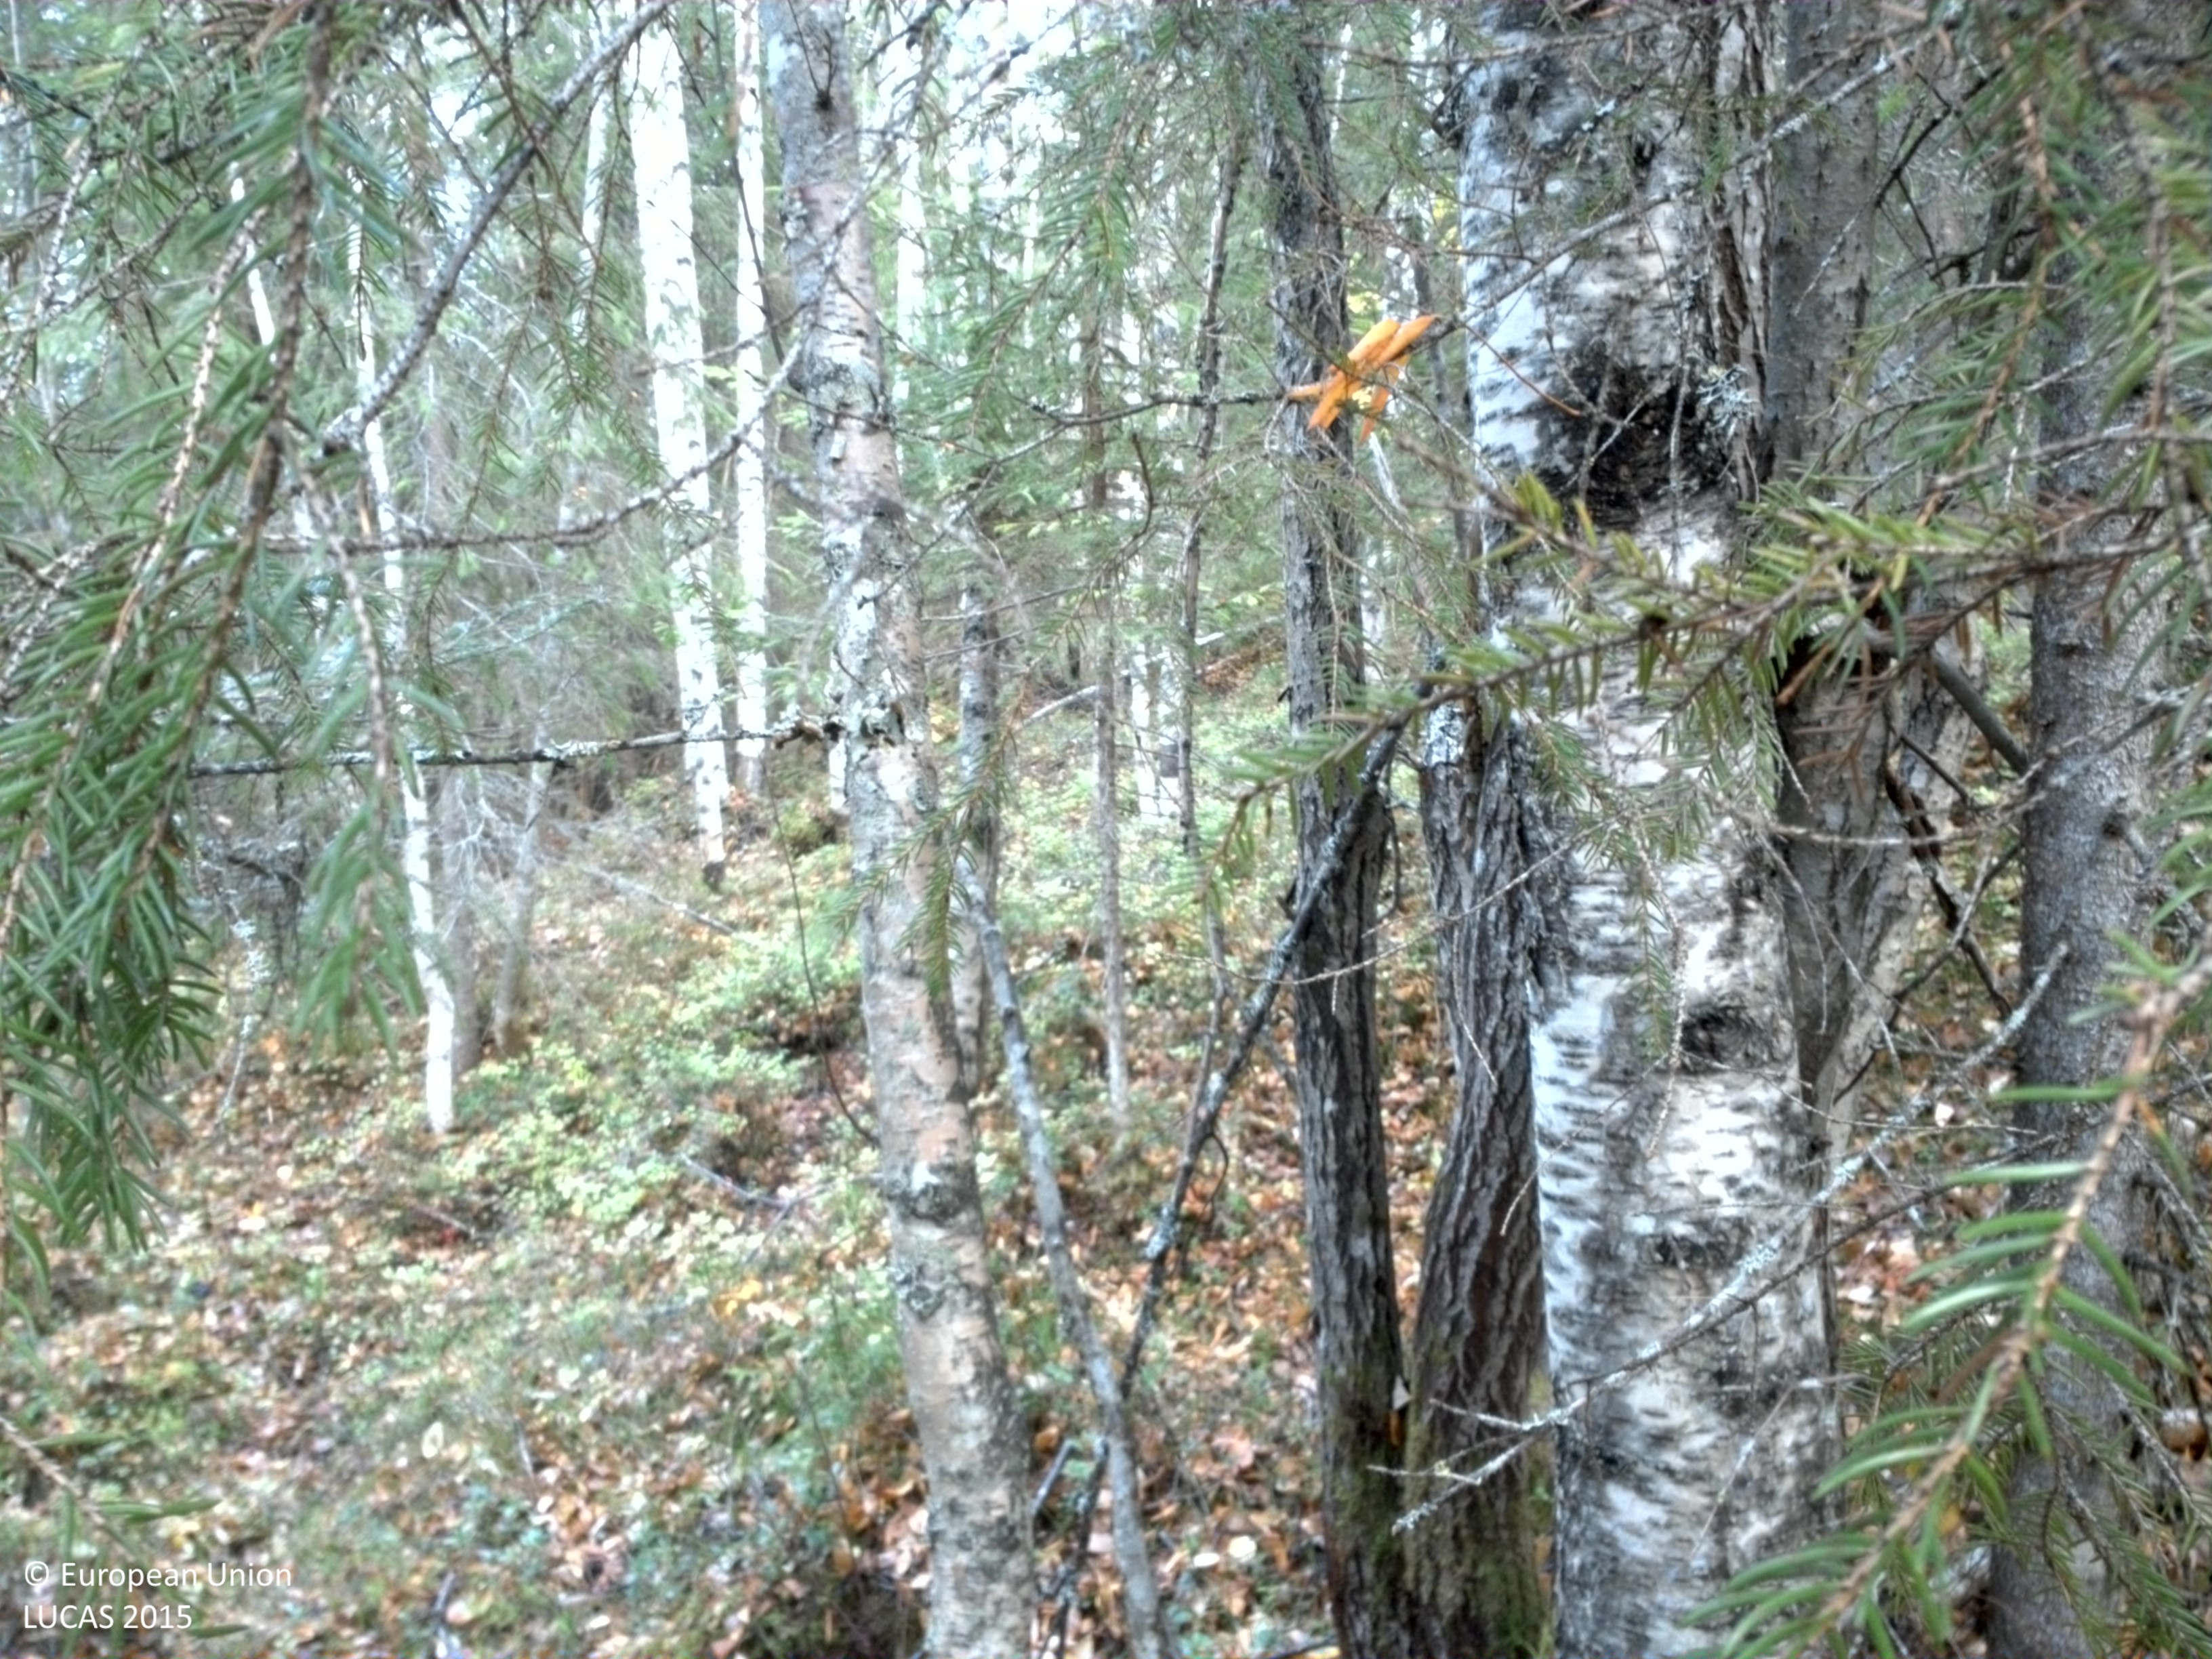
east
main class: Woodland
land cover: Spruce dominated mixed woodland
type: boreal forest
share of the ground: 50 - 75 %
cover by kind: broadleaved forest trees 40 %, coniferous forest trees 25 %, shrubs 20 %, lichens and mosses 10 %, unconsolidated bare surface 5 %
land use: Forestry
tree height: > 5 m
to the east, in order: Spruce dominated mixed woodland; Shrubland with sparse tree cover; Paved roads, cycling and walking lanes; Grassland with sparse tree/shrub cover; Other mixed woodland; Spruce dominated mixed woodland; Other mixed woodland; Tracks; Spruce dominated mixed woodland
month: October
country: SE
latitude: 64.6253
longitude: 16.5550
